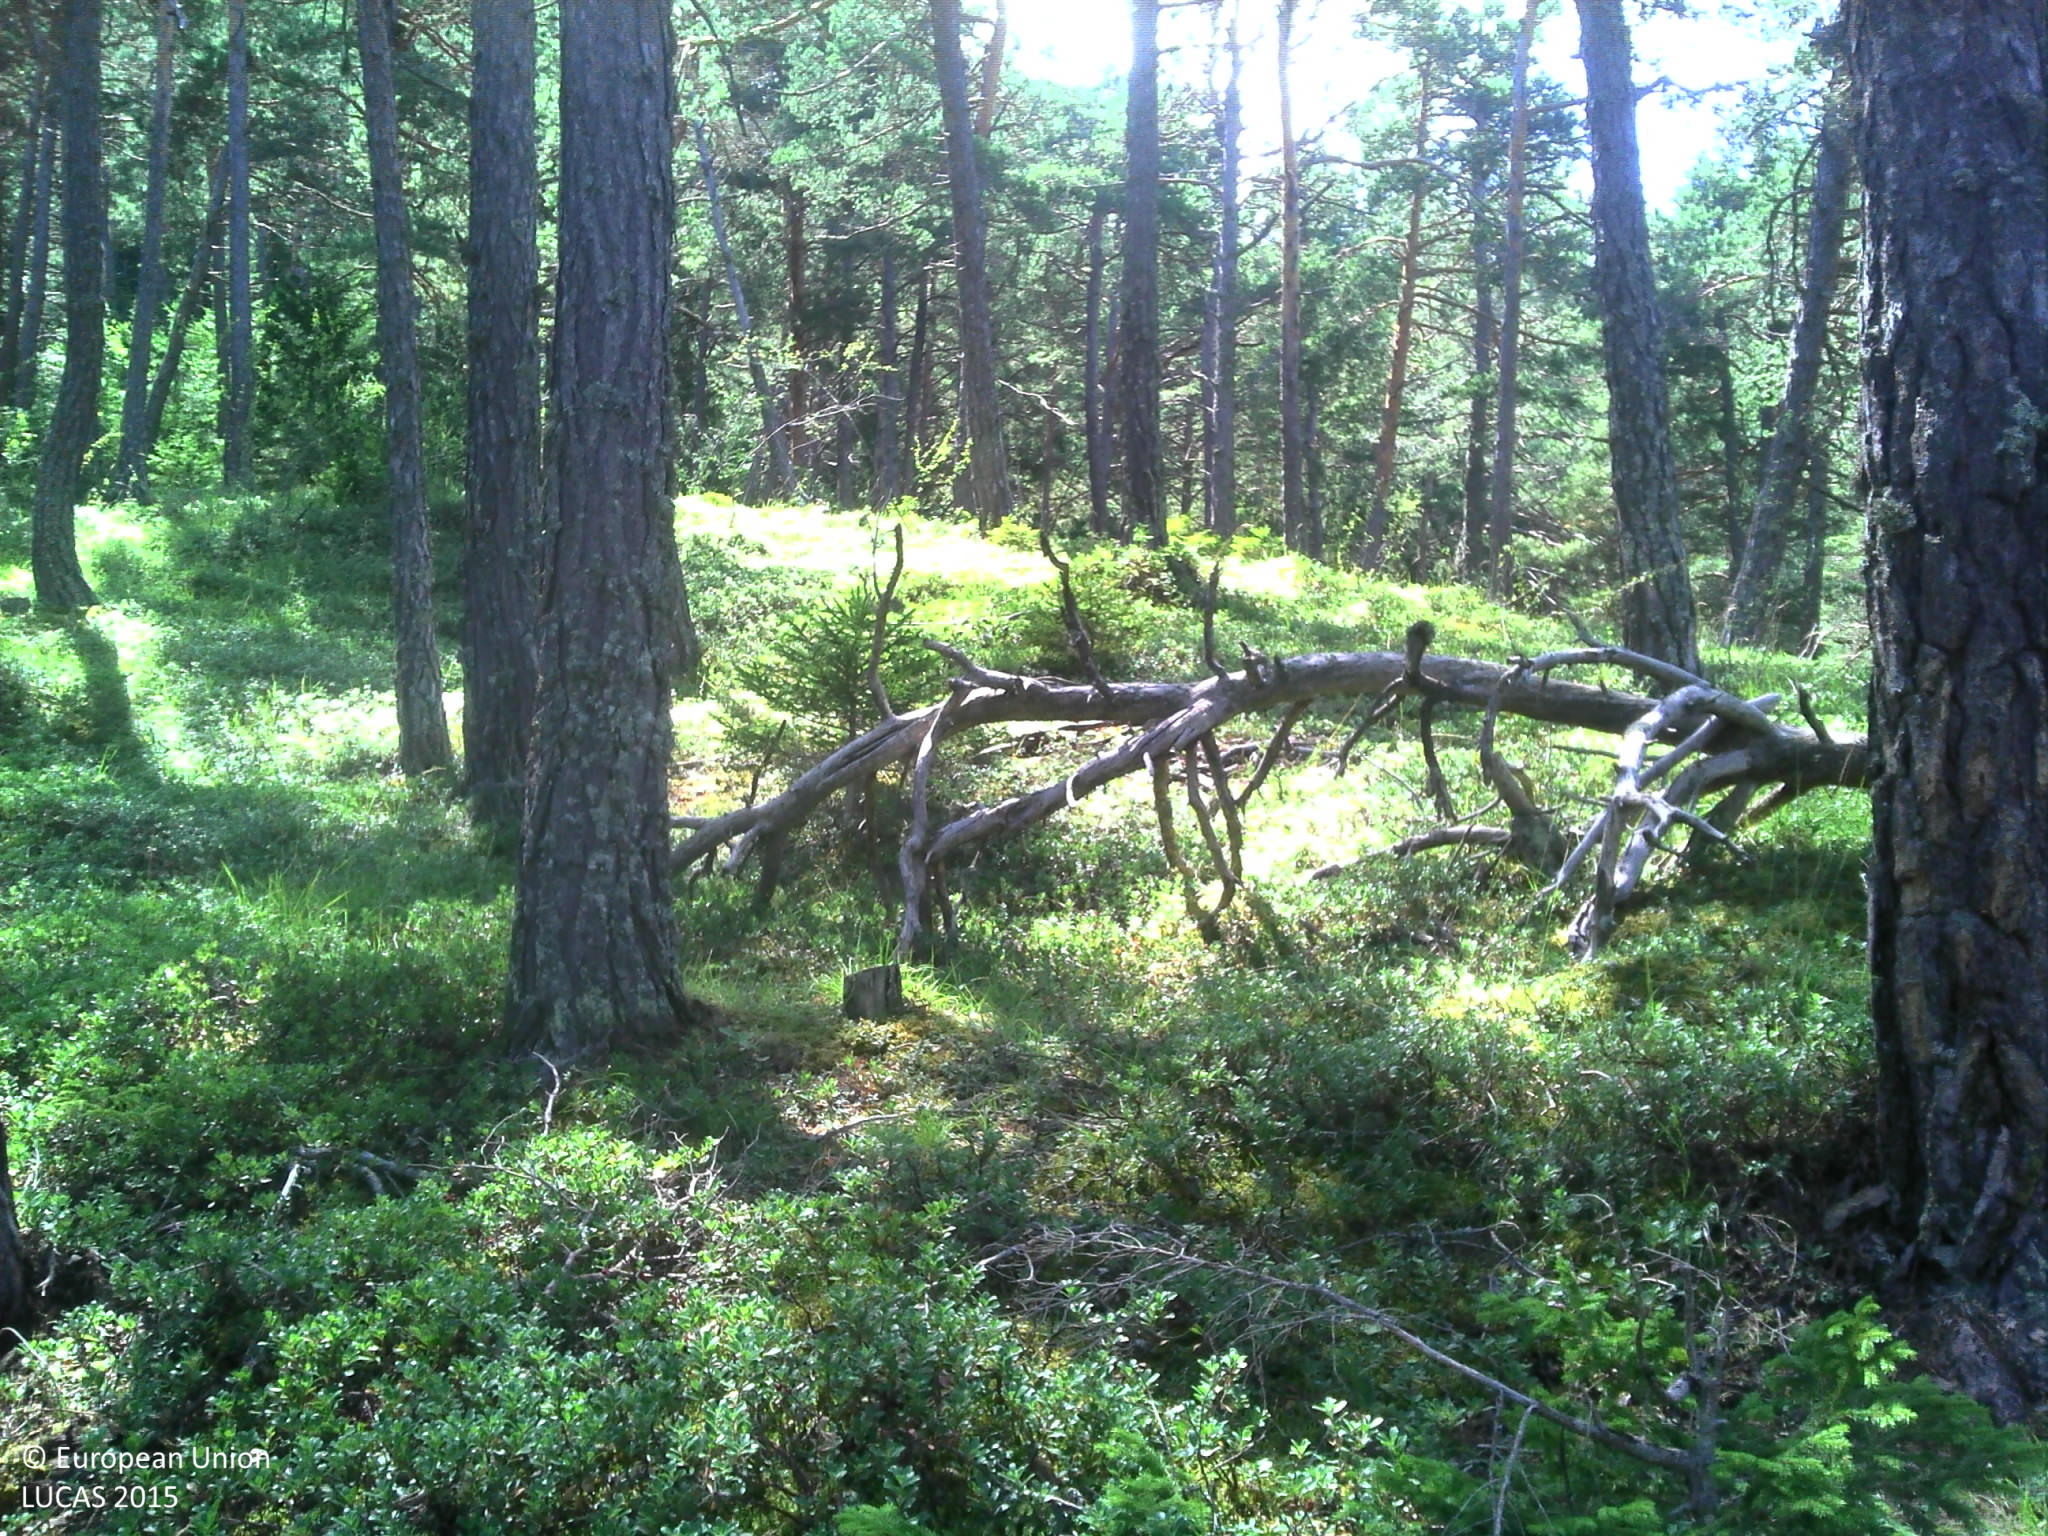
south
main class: Woodland
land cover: Pine dominated coniferous woodland
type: alpine coniferous forest
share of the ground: 50 - 75 %
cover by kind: coniferous forest trees 65 %, lichens and mosses 15 %, shrubs 10 %, herbaceous plants 10 %
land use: Forestry
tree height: > 5 m
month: August
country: FR
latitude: 44.3570
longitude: 6.3057
